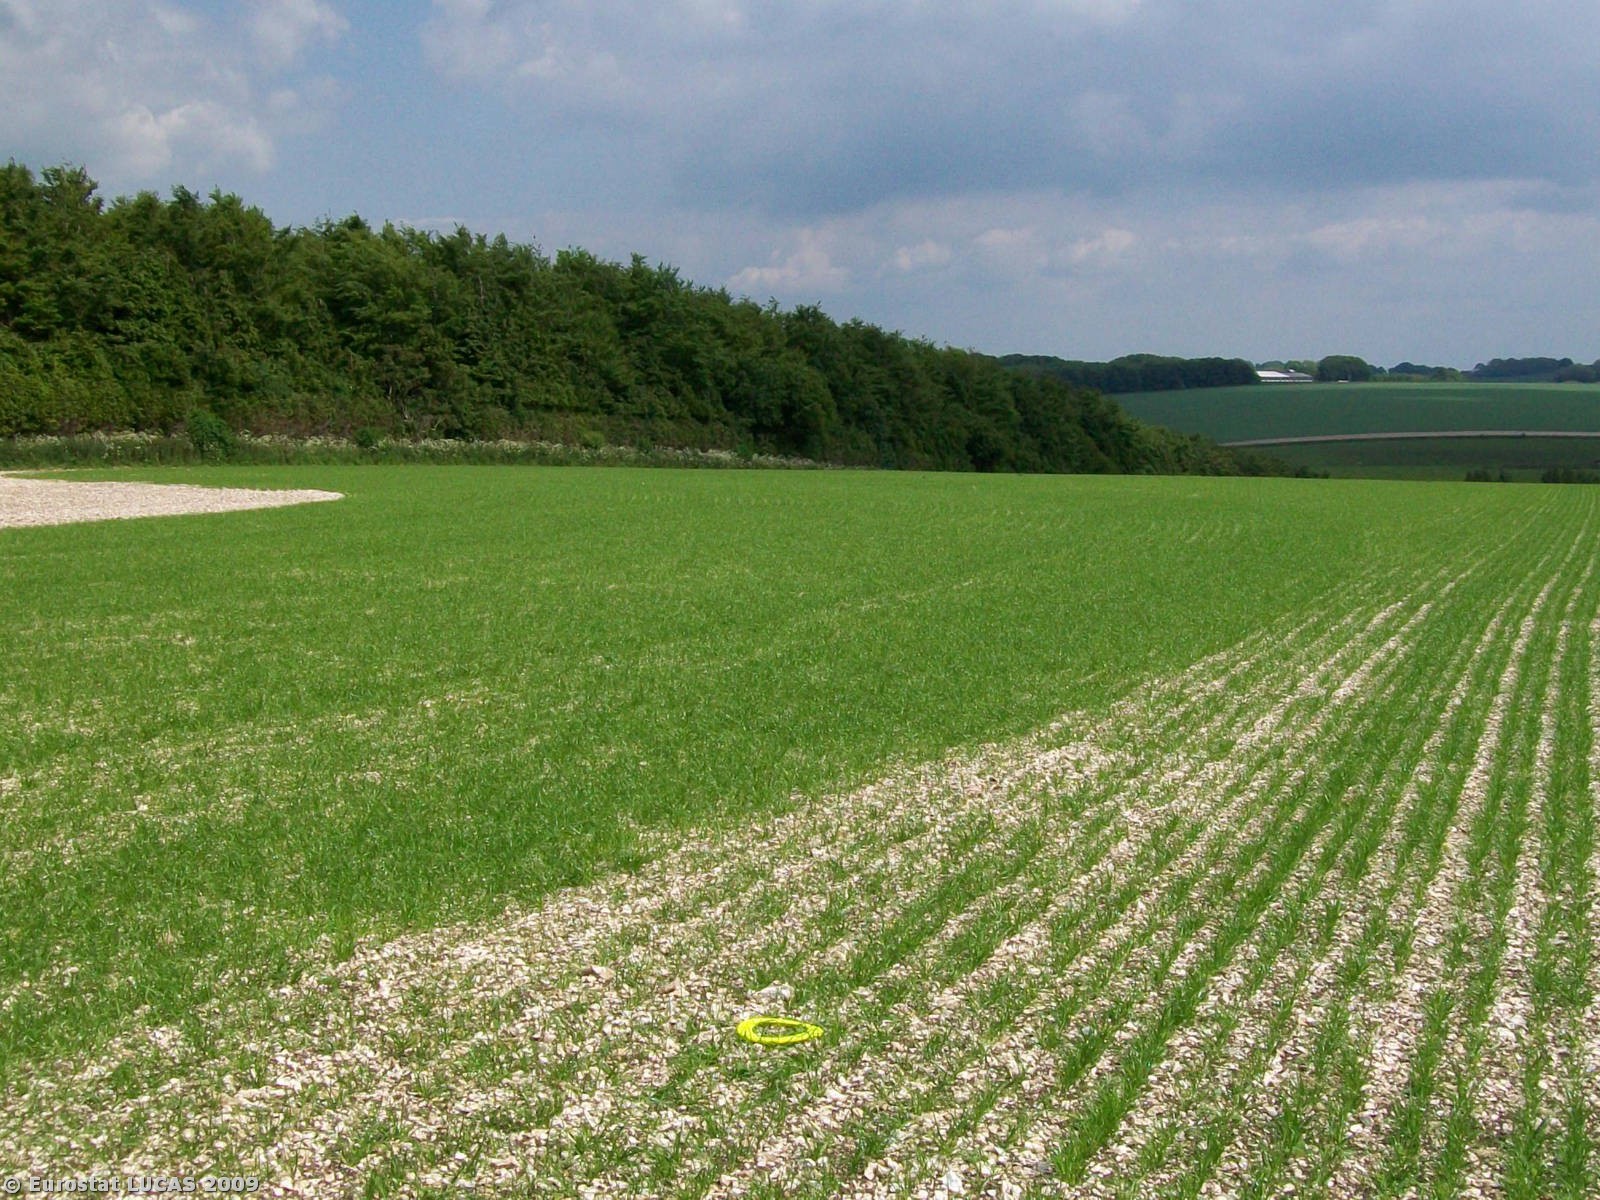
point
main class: Cropland
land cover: Barley
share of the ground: 50 - 75 %
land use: Agriculture (excluding fallow land and kitchen gardens)
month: May
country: GB
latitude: 51.1246
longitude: -2.2210
